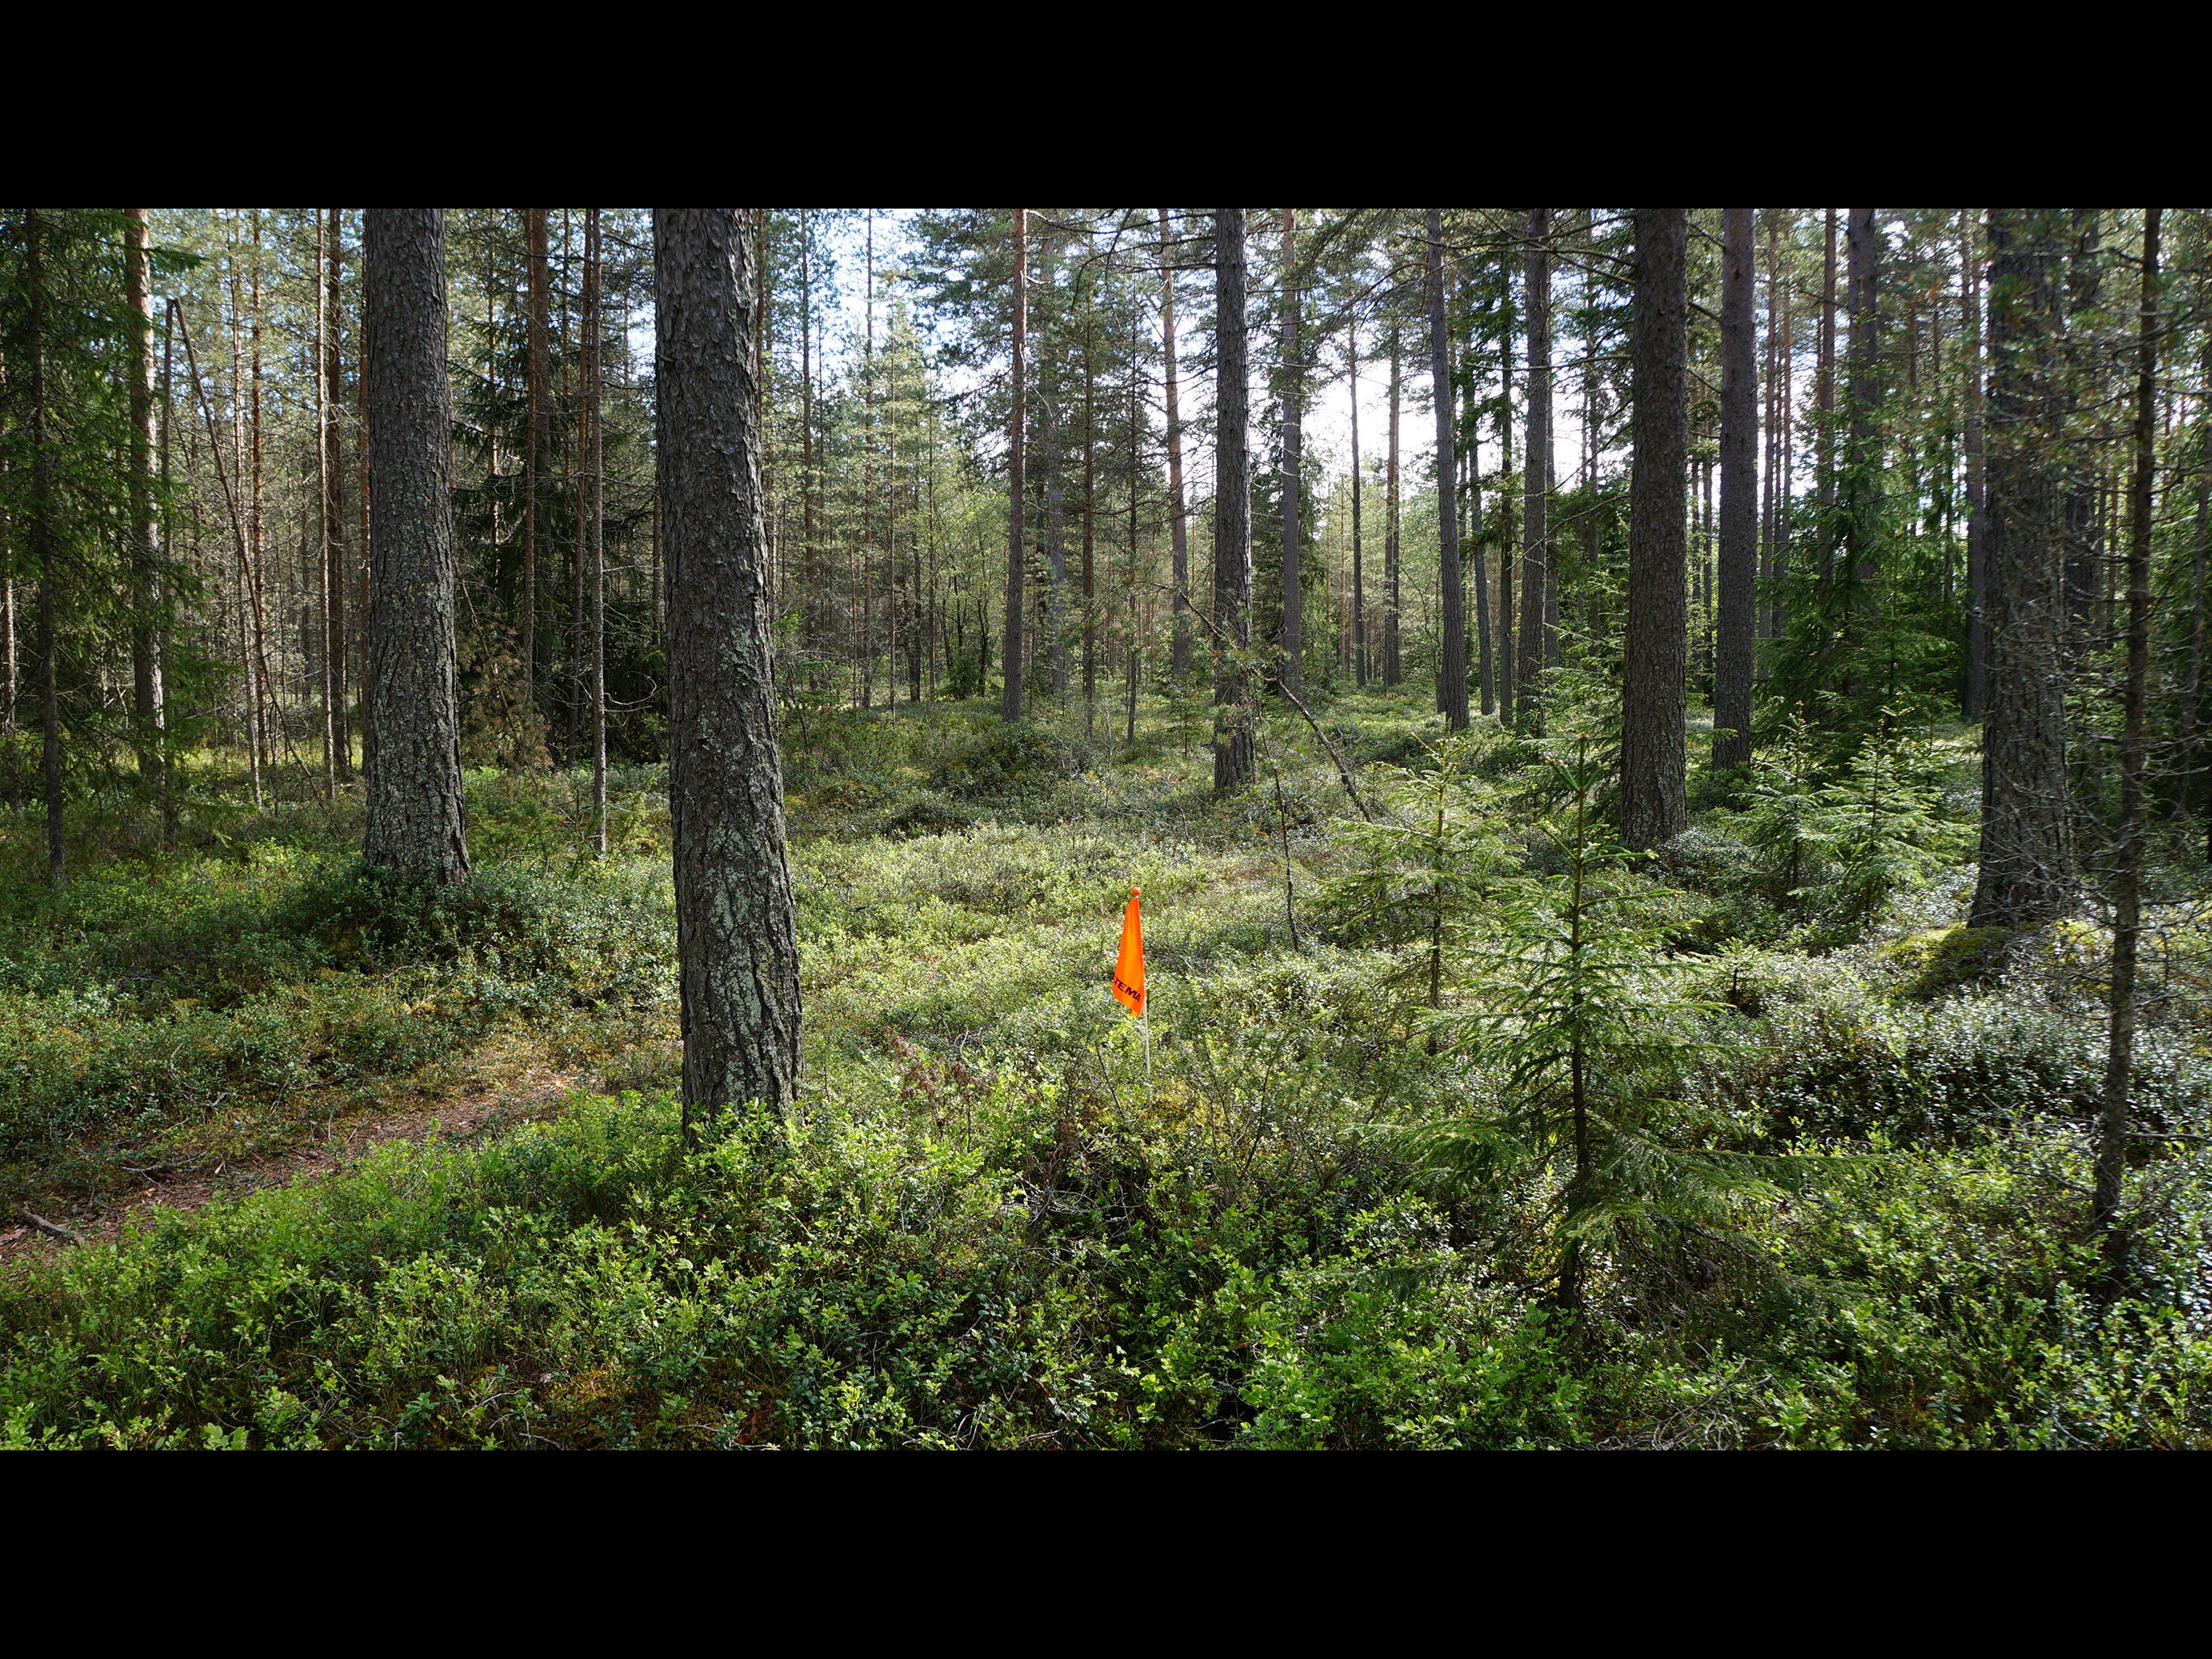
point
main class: Woodland
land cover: Pine dominated coniferous woodland
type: boreal forest
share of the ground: 50 - 75 %
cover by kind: coniferous forest trees 70 %, herbaceous plants 15 %, broadleaved forest trees 5 %, shrubs 5 %, lichens and mosses 5 %
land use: Forestry
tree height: > 5 m
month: June
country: FI
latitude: 64.2461
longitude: 23.8601
